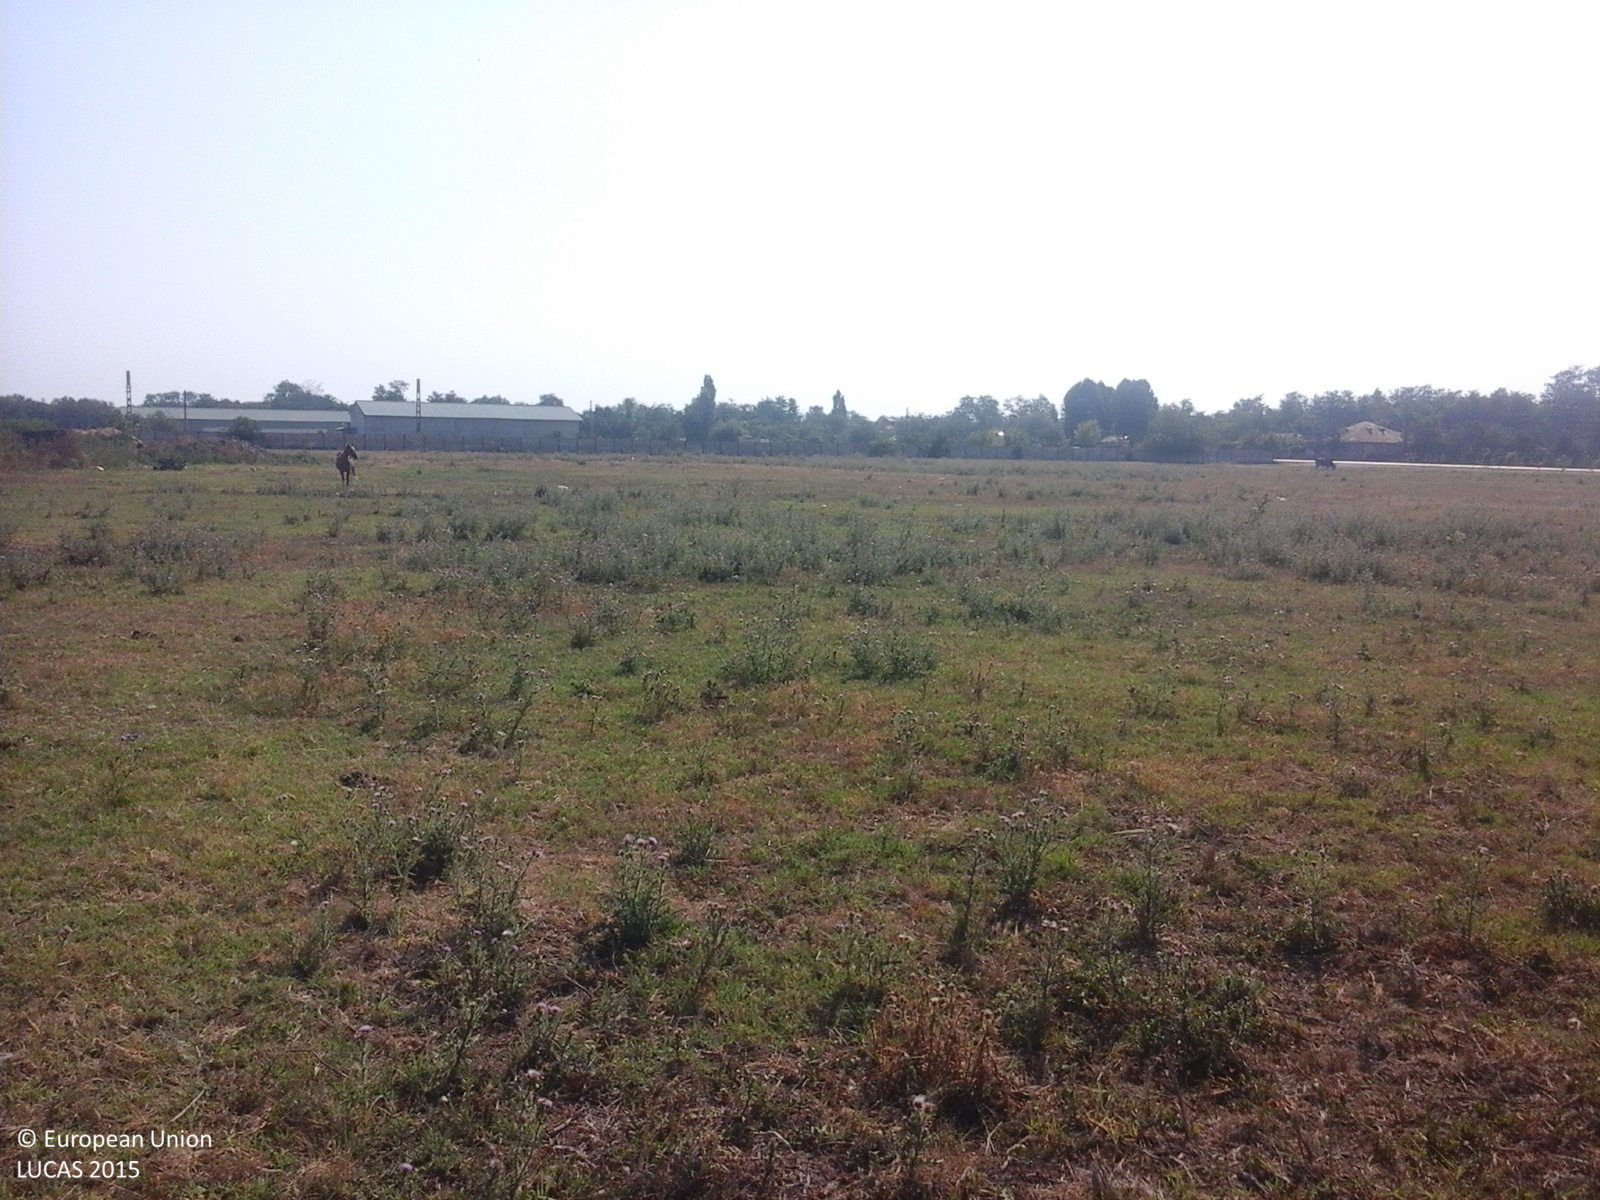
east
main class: Grassland
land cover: Grassland without tree/shrub cover
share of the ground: > 75 %
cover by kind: herbaceous plants 100 %
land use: Agriculture (excluding fallow land and kitchen gardens)
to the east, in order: Grassland without tree/shrub cover; Tracks; Grass margins; Fences; Grassland without tree/shrub cover
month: August
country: RO
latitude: 45.1183
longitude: 27.3707
